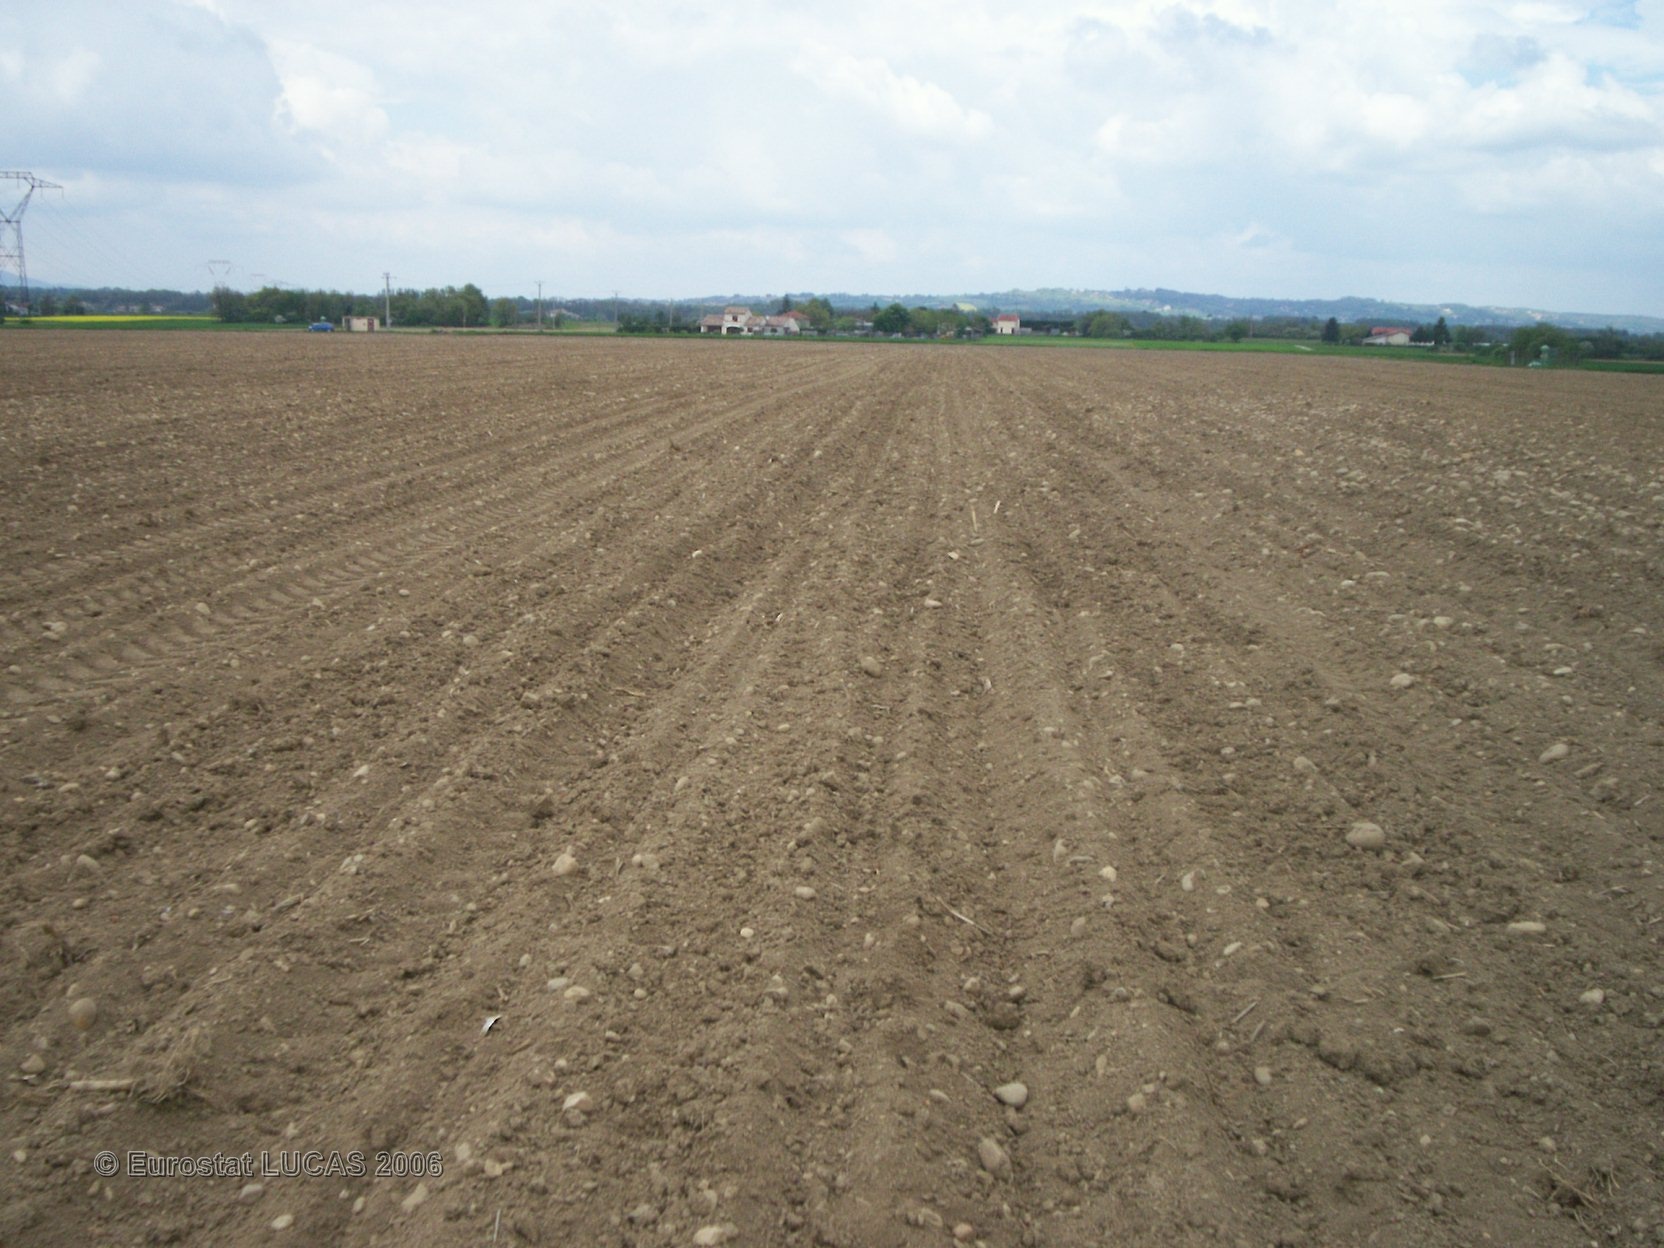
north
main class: Cropland
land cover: Maize
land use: Agriculture (excluding fallow land and kitchen gardens)
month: April
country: FR
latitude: 45.2893
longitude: 4.8664
